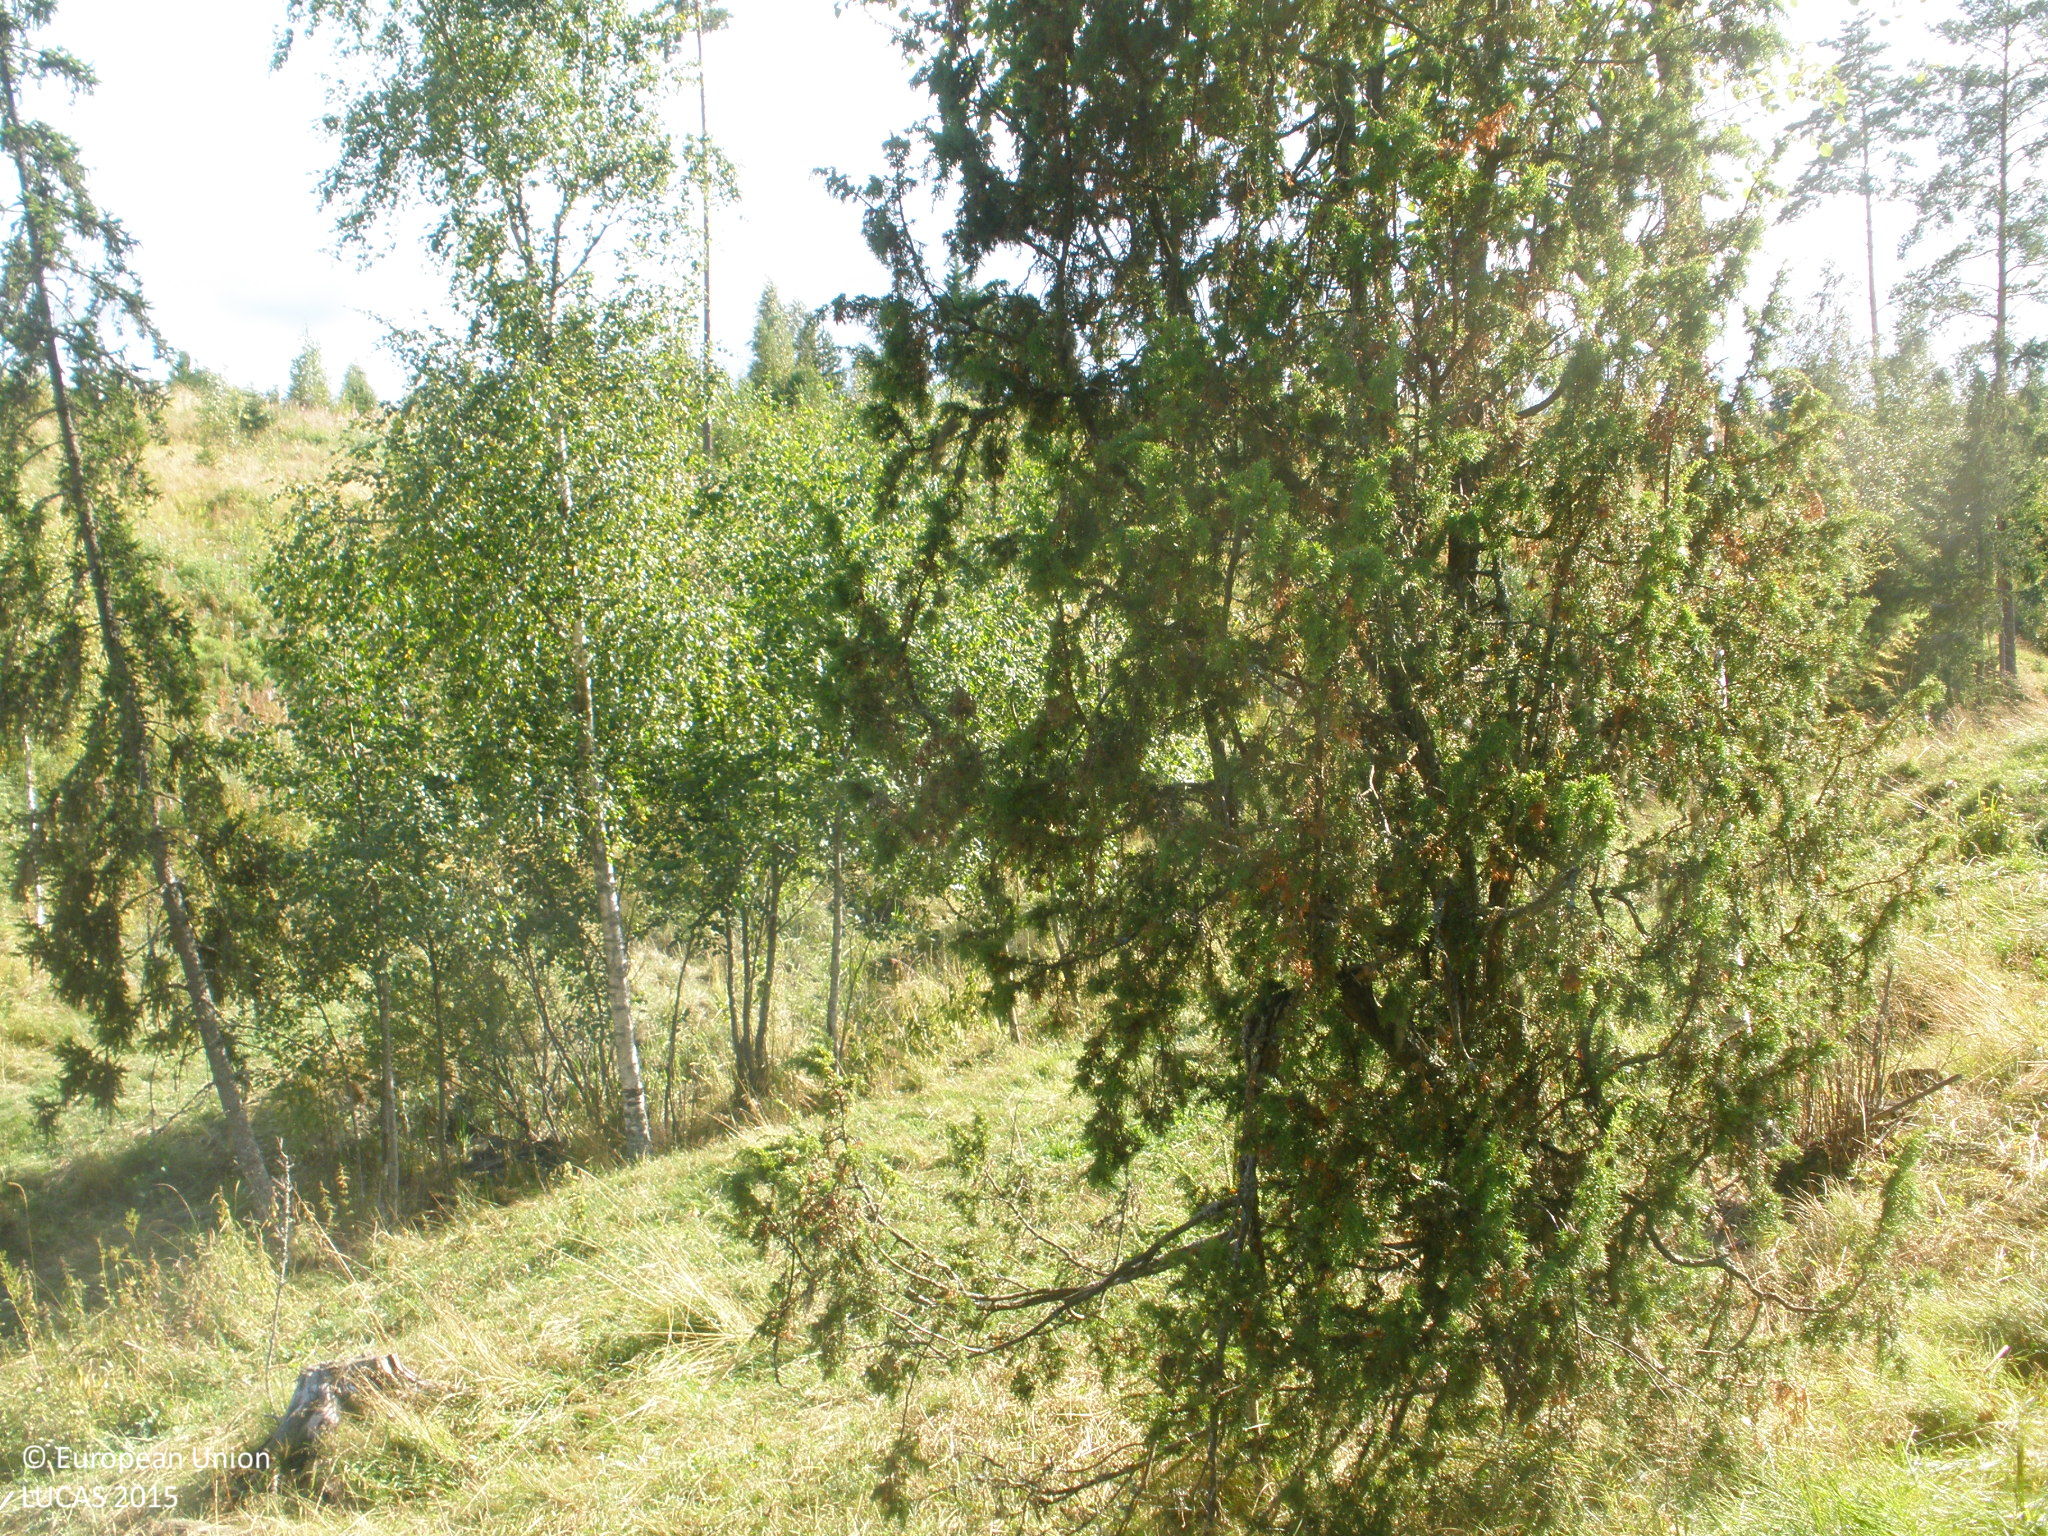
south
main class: Grassland
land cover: Grassland with sparse tree/shrub cover
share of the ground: > 75 %
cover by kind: herbaceous plants 85 %, broadleaved forest trees 5 %, shrubs 5 %, unconsolidated bare surface 5 %
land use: Agriculture (excluding fallow land and kitchen gardens)
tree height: < 5 m
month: August
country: FI
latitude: 60.6027
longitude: 23.3609
